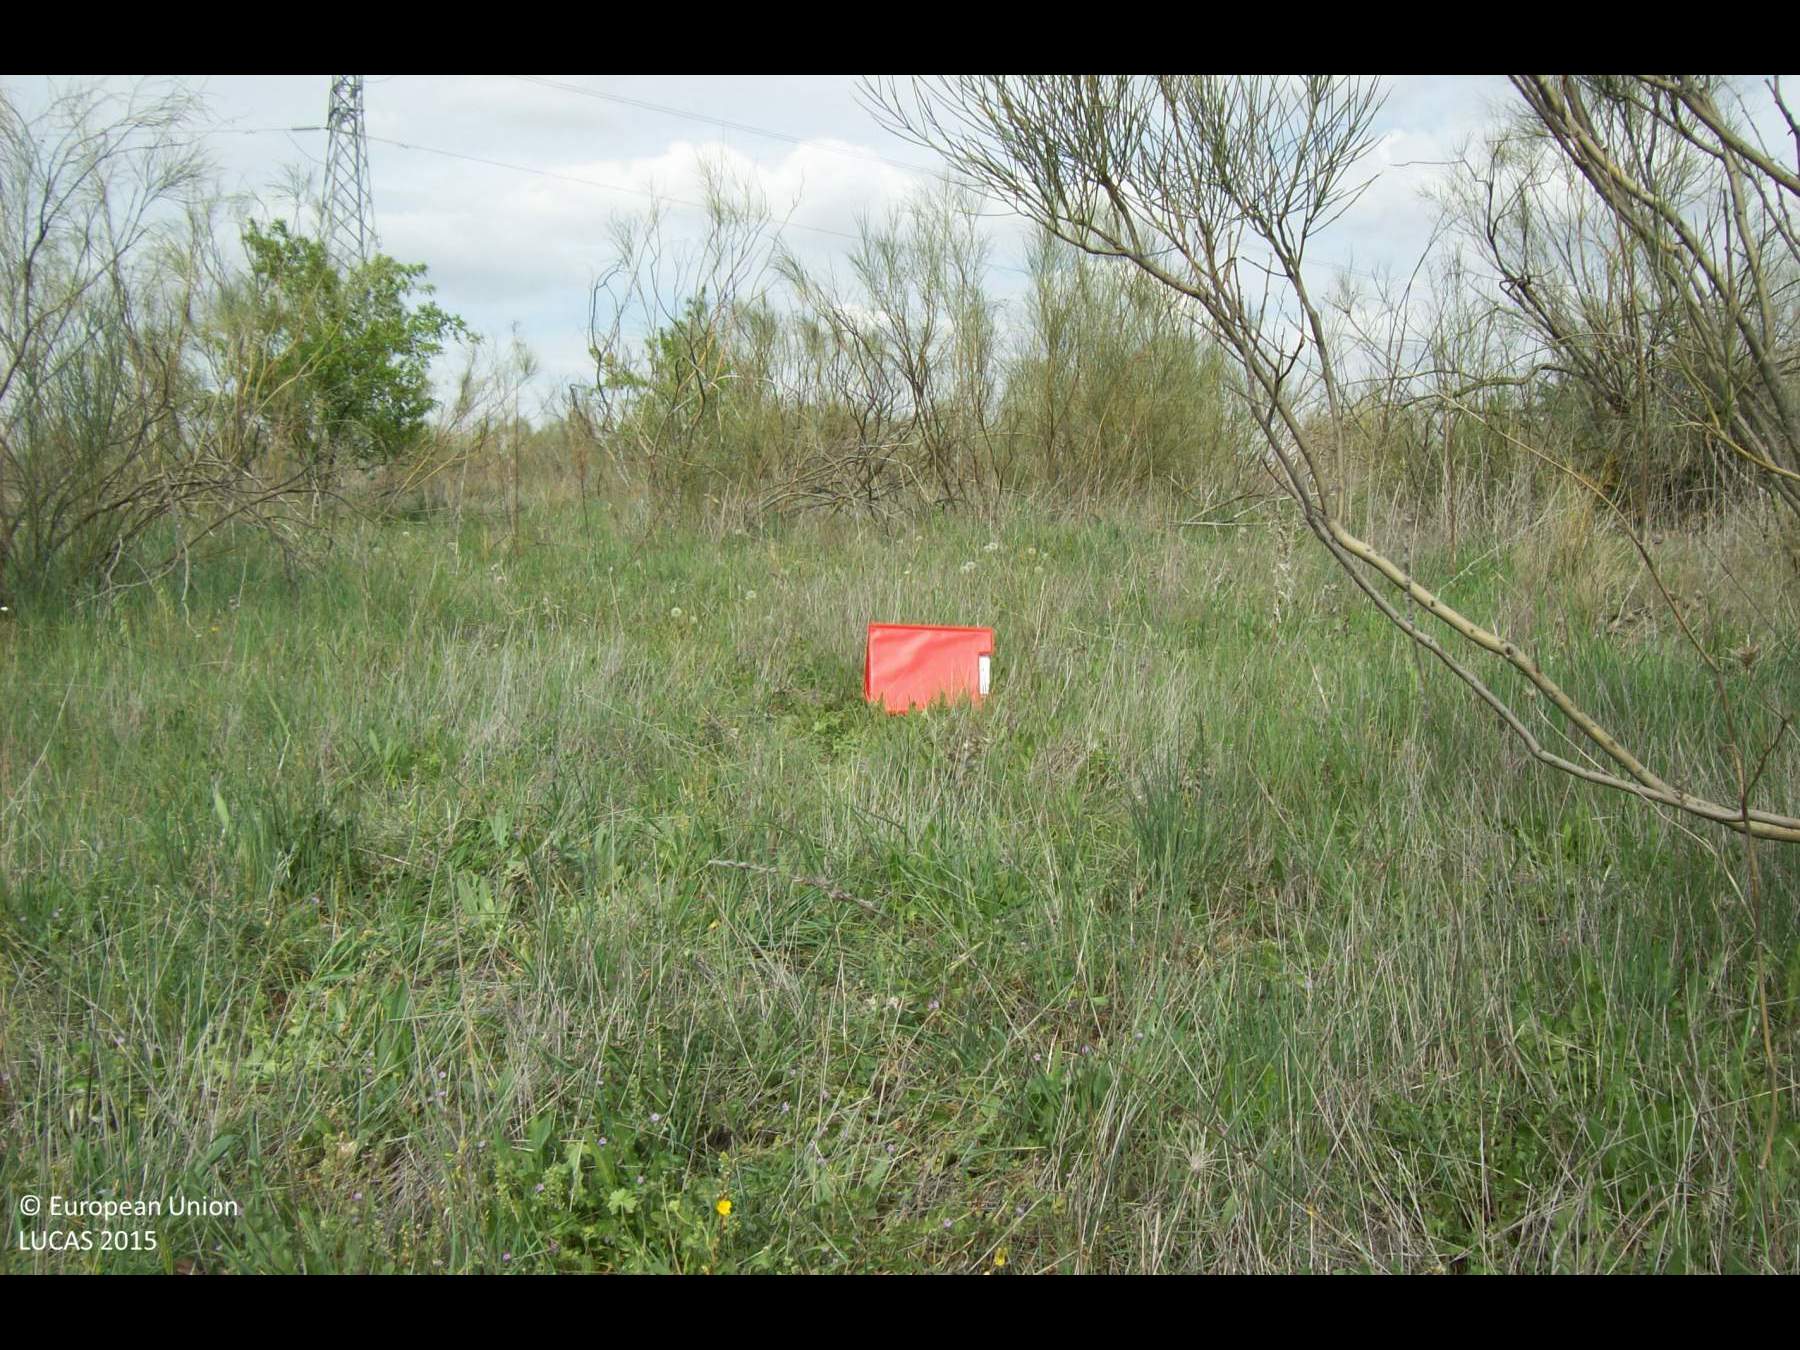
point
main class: Shrubland
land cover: Shrubland without tree cover
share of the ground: > 75 %
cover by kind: shrubs 50 %, herbaceous plants 50 %
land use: Semi-natural and natural areas not in use
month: April
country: ES
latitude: 40.4784
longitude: -3.9252
